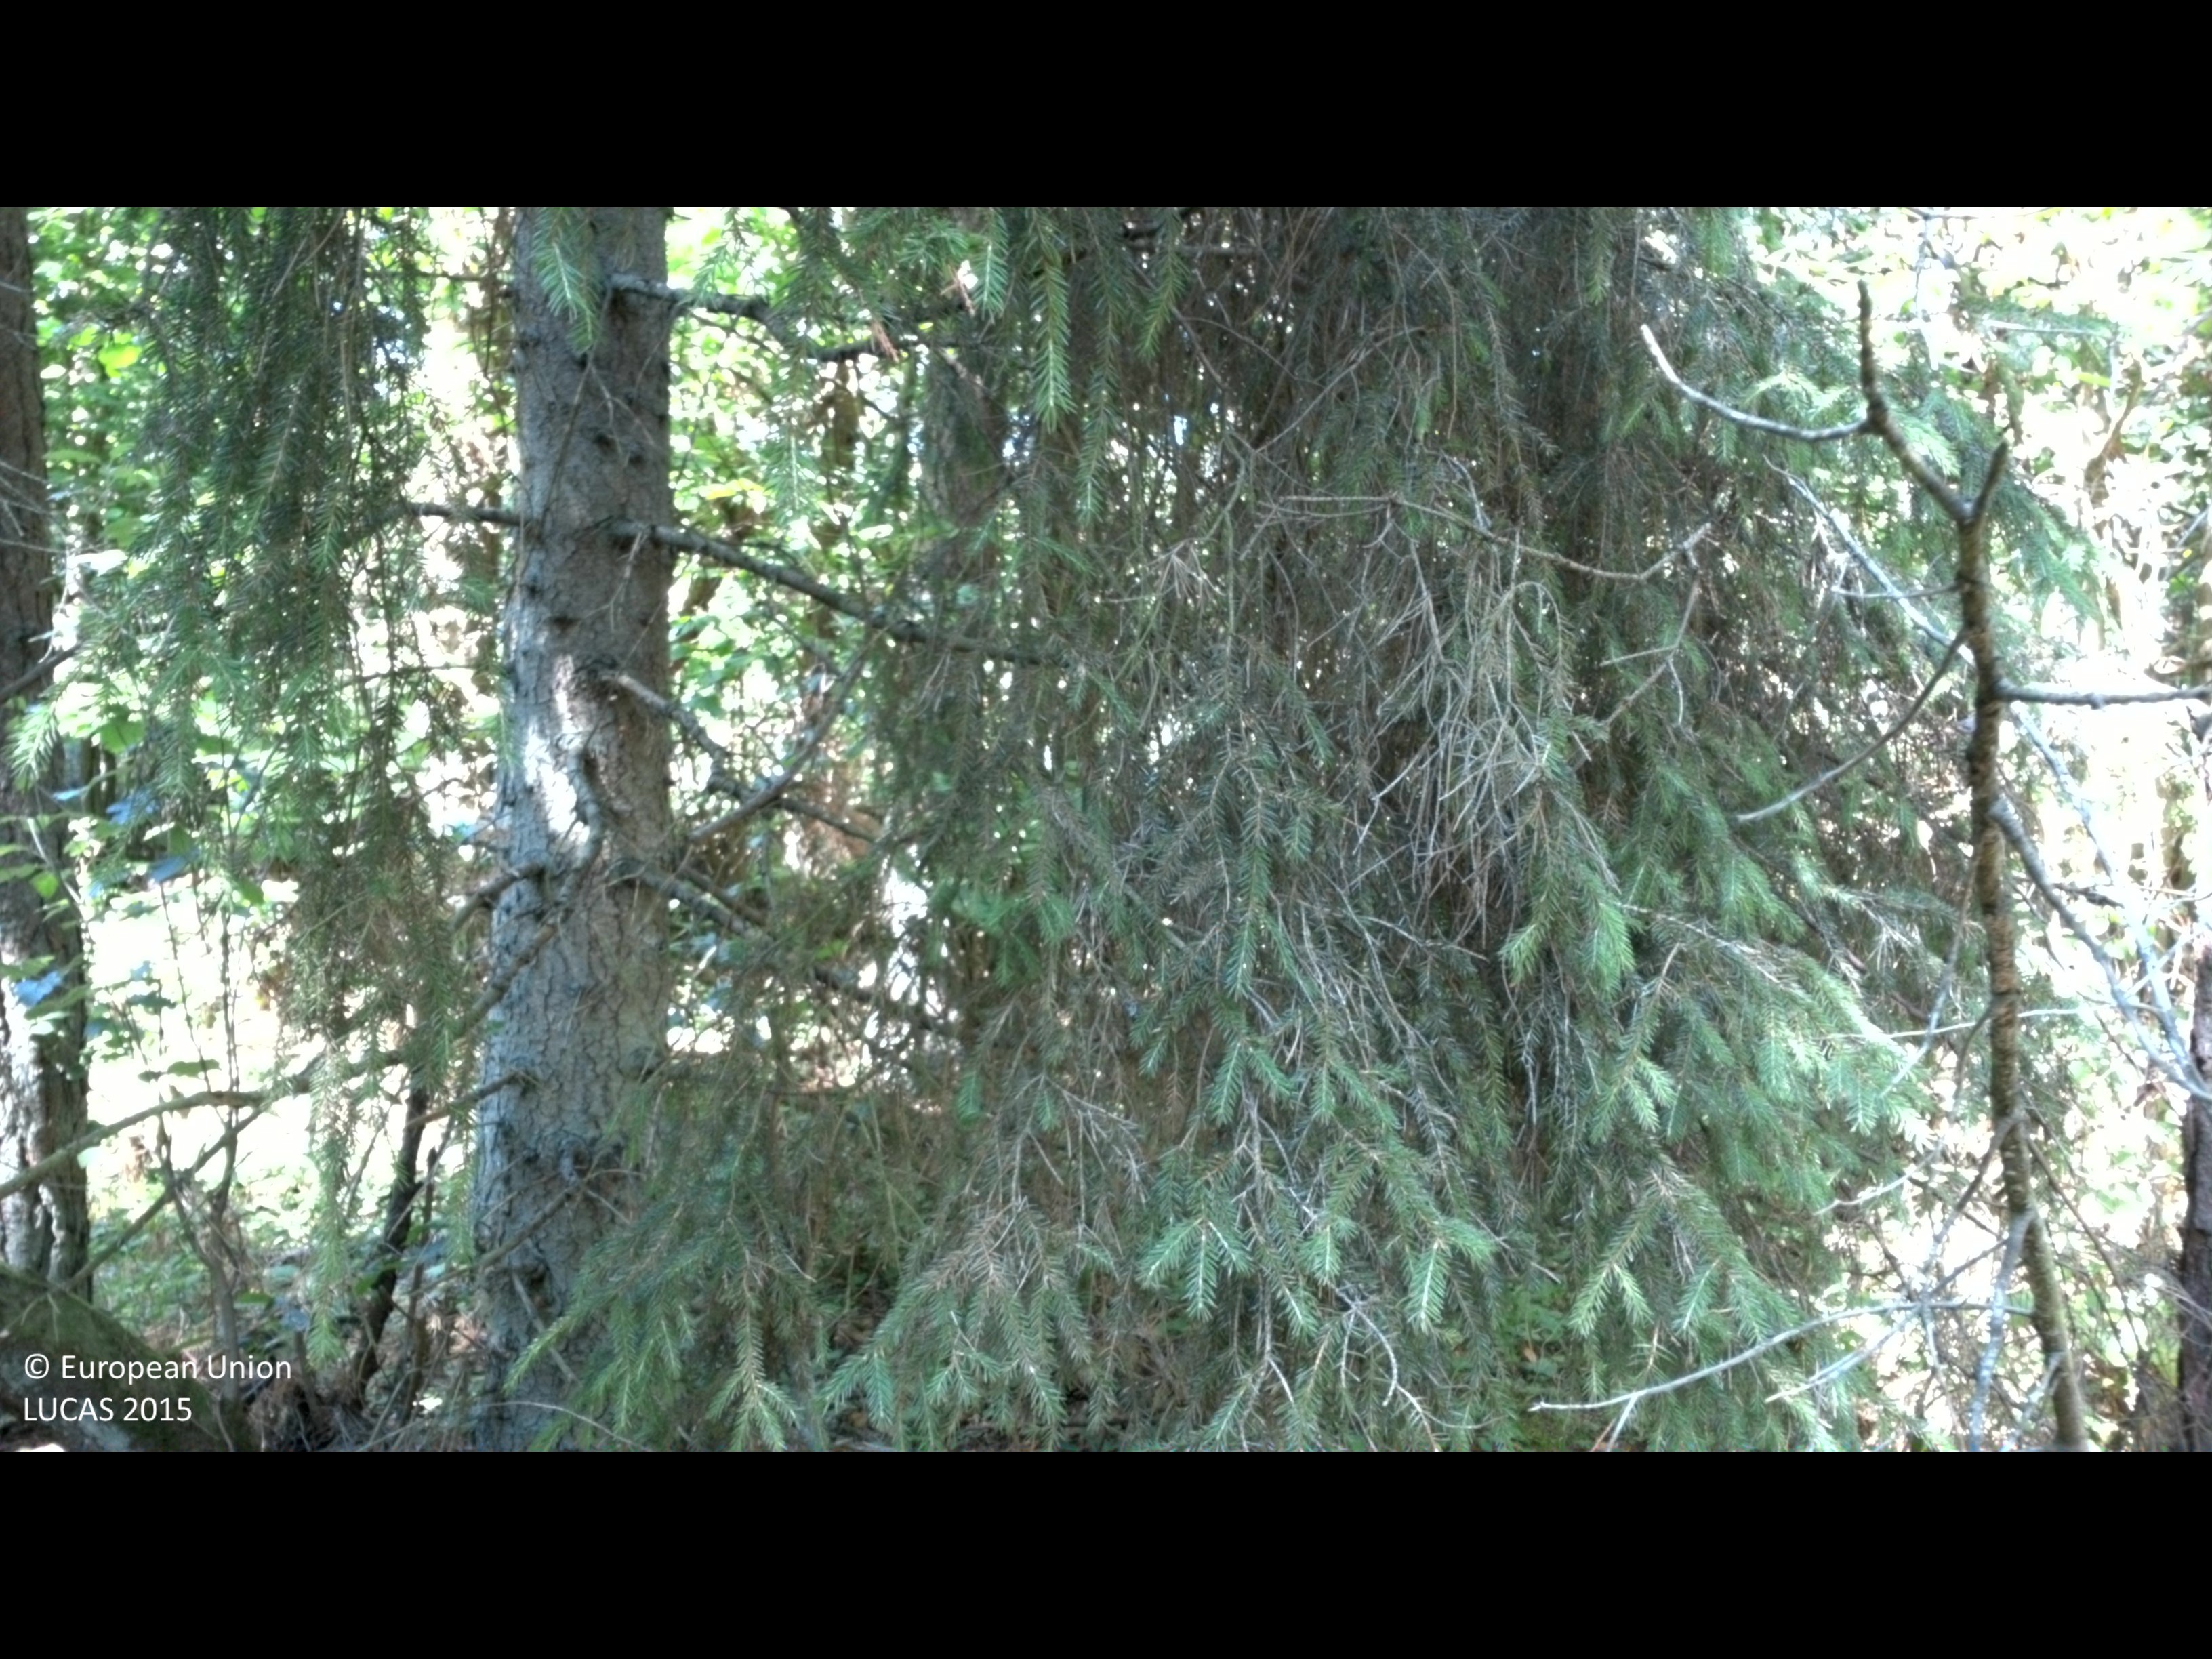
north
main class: Woodland
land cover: Pine dominated coniferous woodland
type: boreal forest
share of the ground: 50 - 75 %
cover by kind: coniferous forest trees 65 %, shrubs 30 %, herbaceous plants 5 %
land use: Forestry
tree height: > 5 m
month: July
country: SE
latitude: 56.5954
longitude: 16.5978
